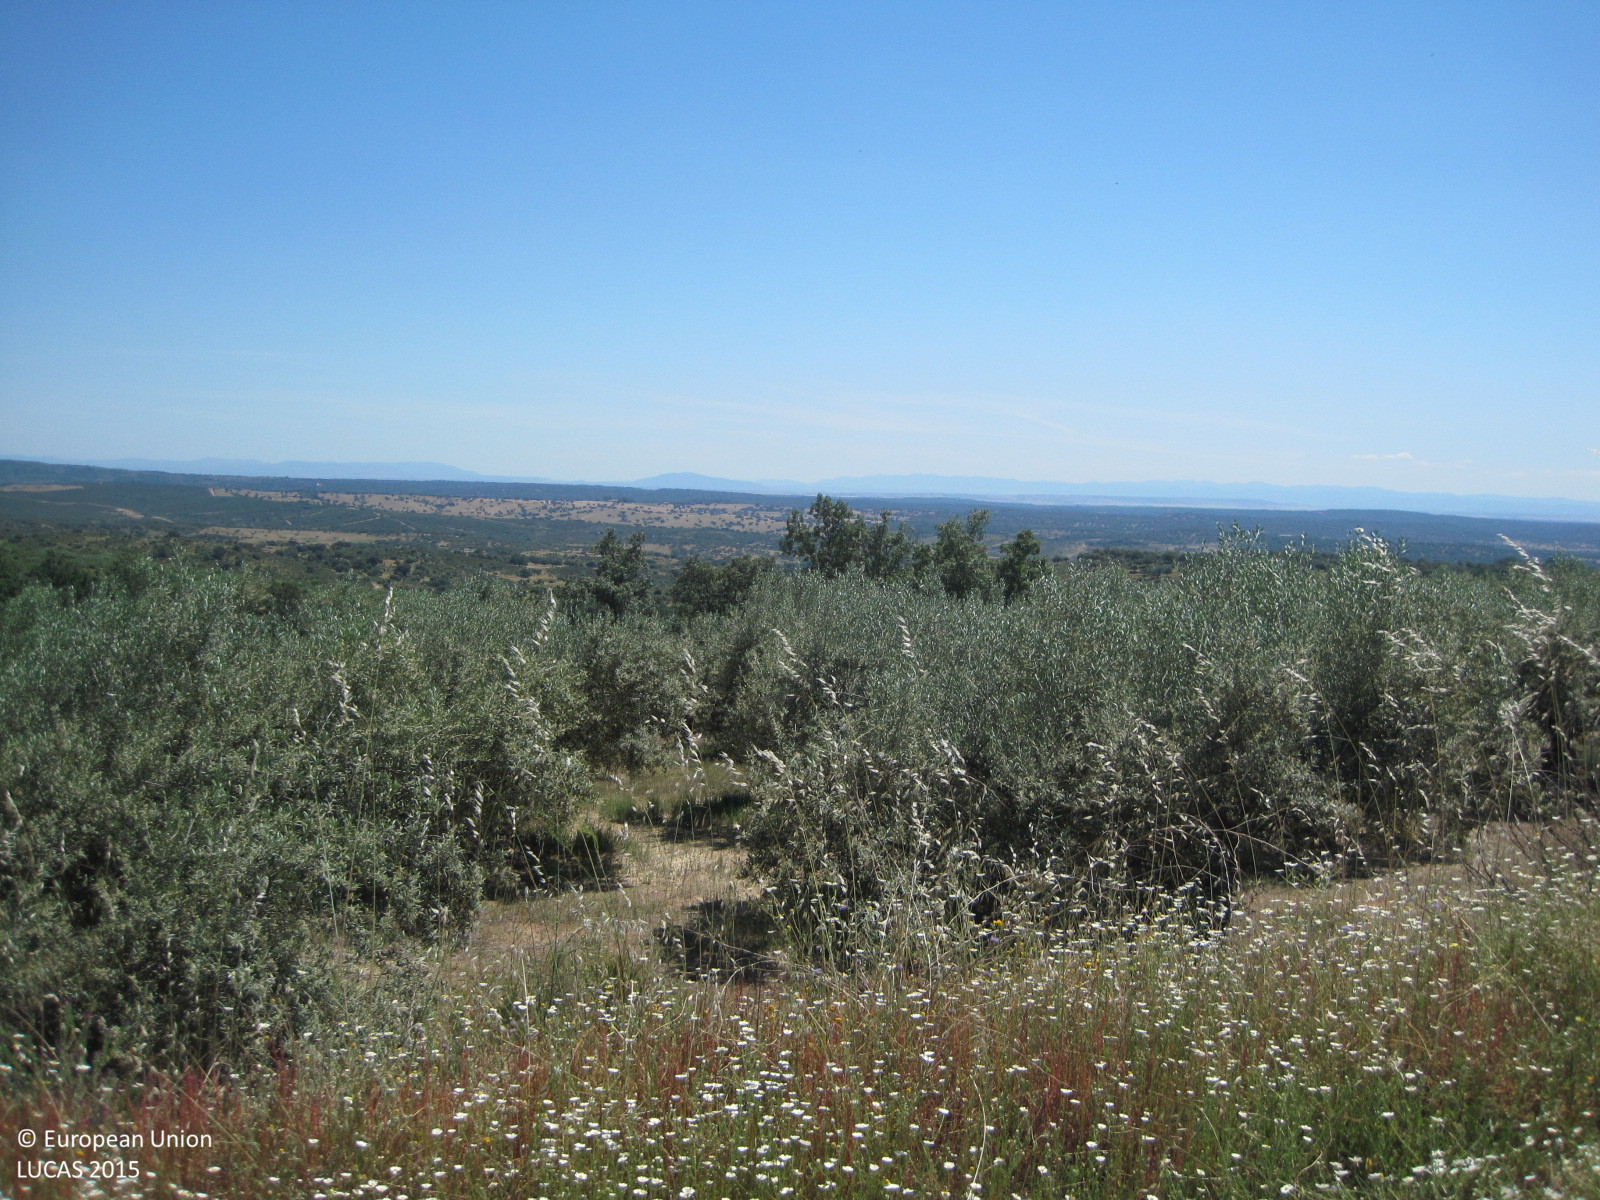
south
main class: Cropland
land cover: Other fruit trees and berries
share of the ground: < 10 %
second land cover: Grassland without tree/shrub cover
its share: 50 - 75 %
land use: Agriculture (excluding fallow land and kitchen gardens)
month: May
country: ES
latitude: 40.1642
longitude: -5.1676
